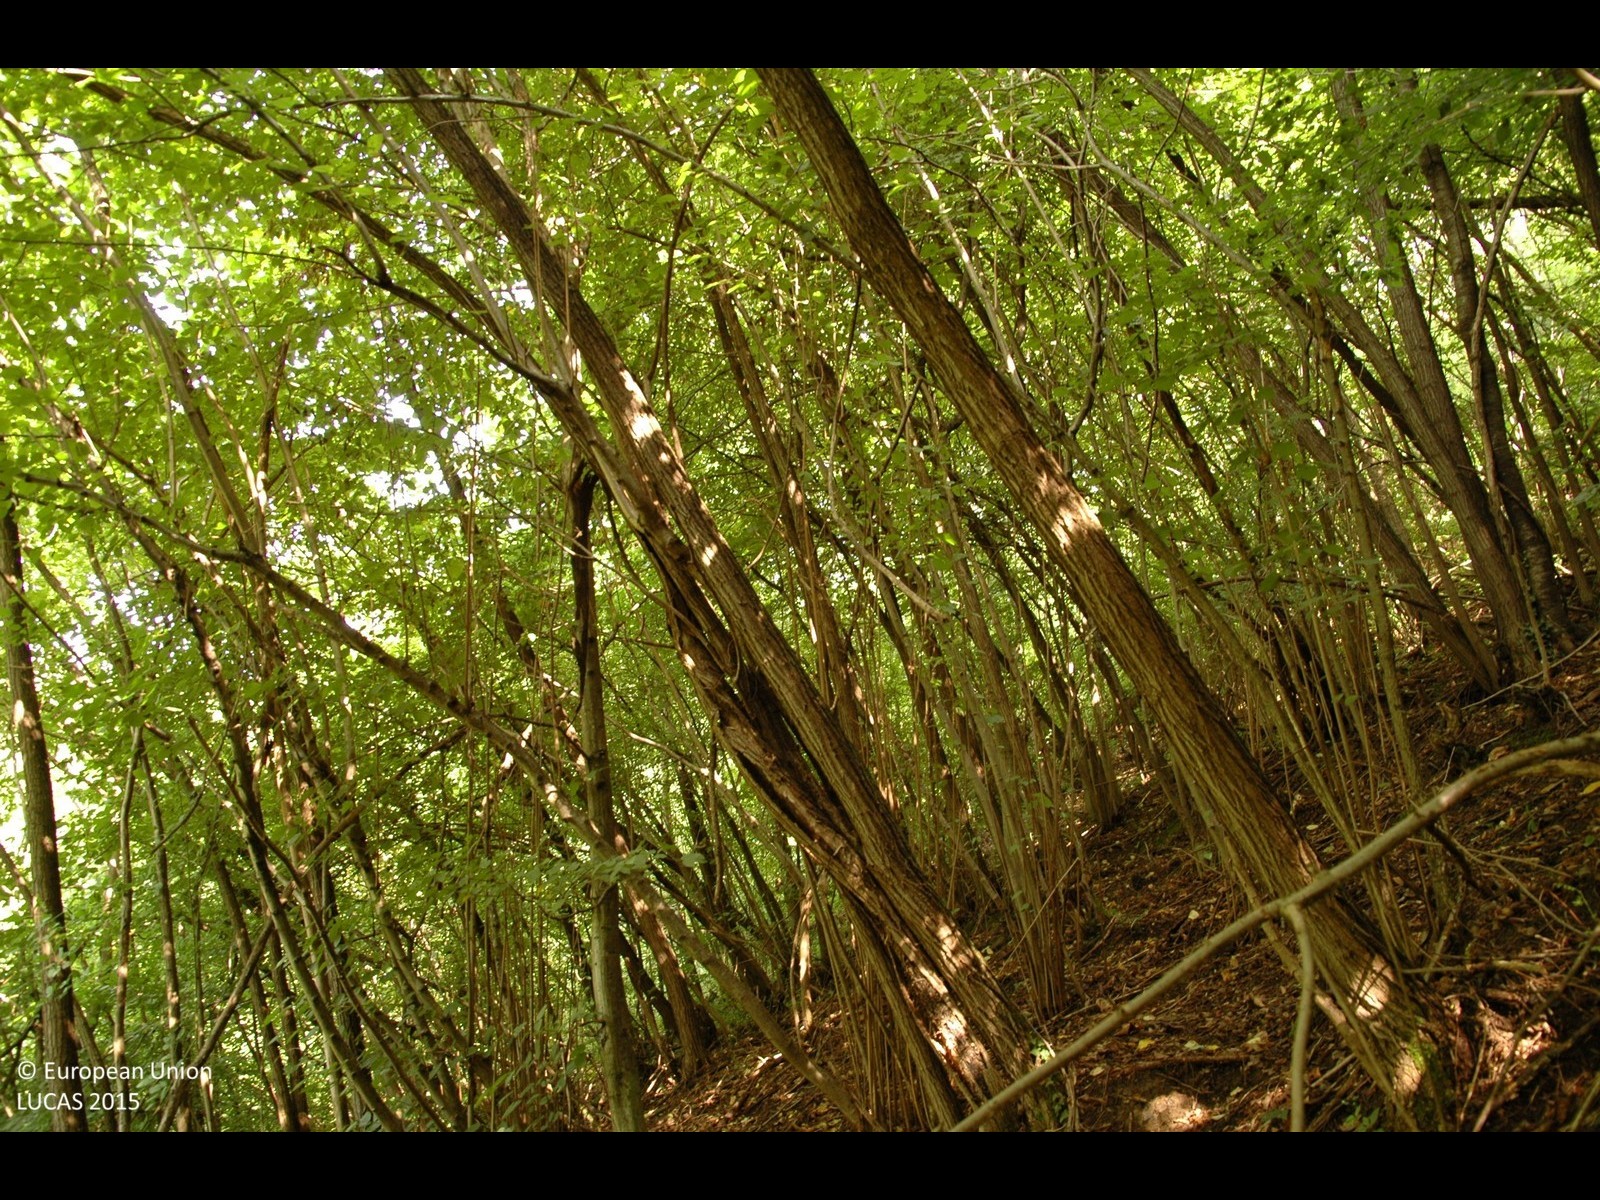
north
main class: Woodland
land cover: Broadleaved woodland
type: mesophytic deciduous forest
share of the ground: > 75 %
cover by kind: broadleaved forest trees 100 %
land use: Forestry
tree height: > 5 m
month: August
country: HR
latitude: 45.9408
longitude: 16.1255
